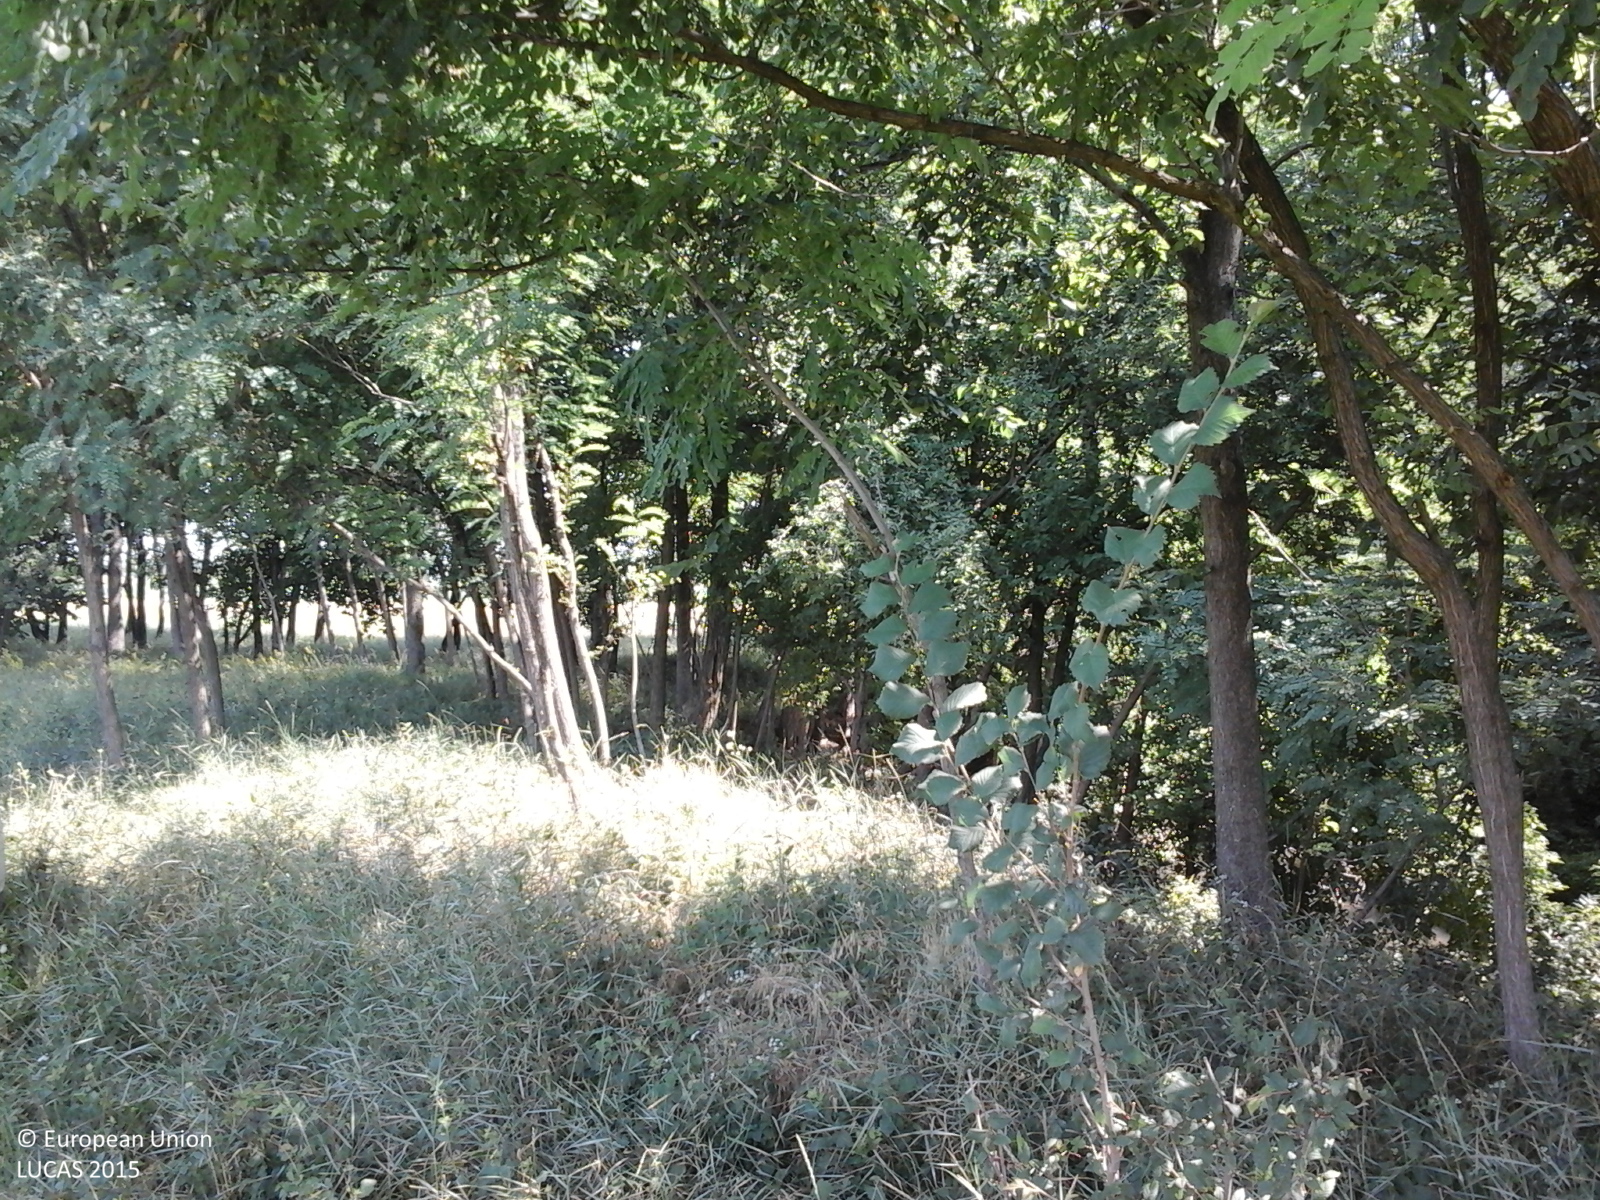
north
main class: Grassland
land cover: Grassland without tree/shrub cover
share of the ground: > 75 %
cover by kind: herbaceous plants 100 %
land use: Agriculture (excluding fallow land and kitchen gardens)
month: July
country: RO
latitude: 44.7155
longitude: 25.6365
